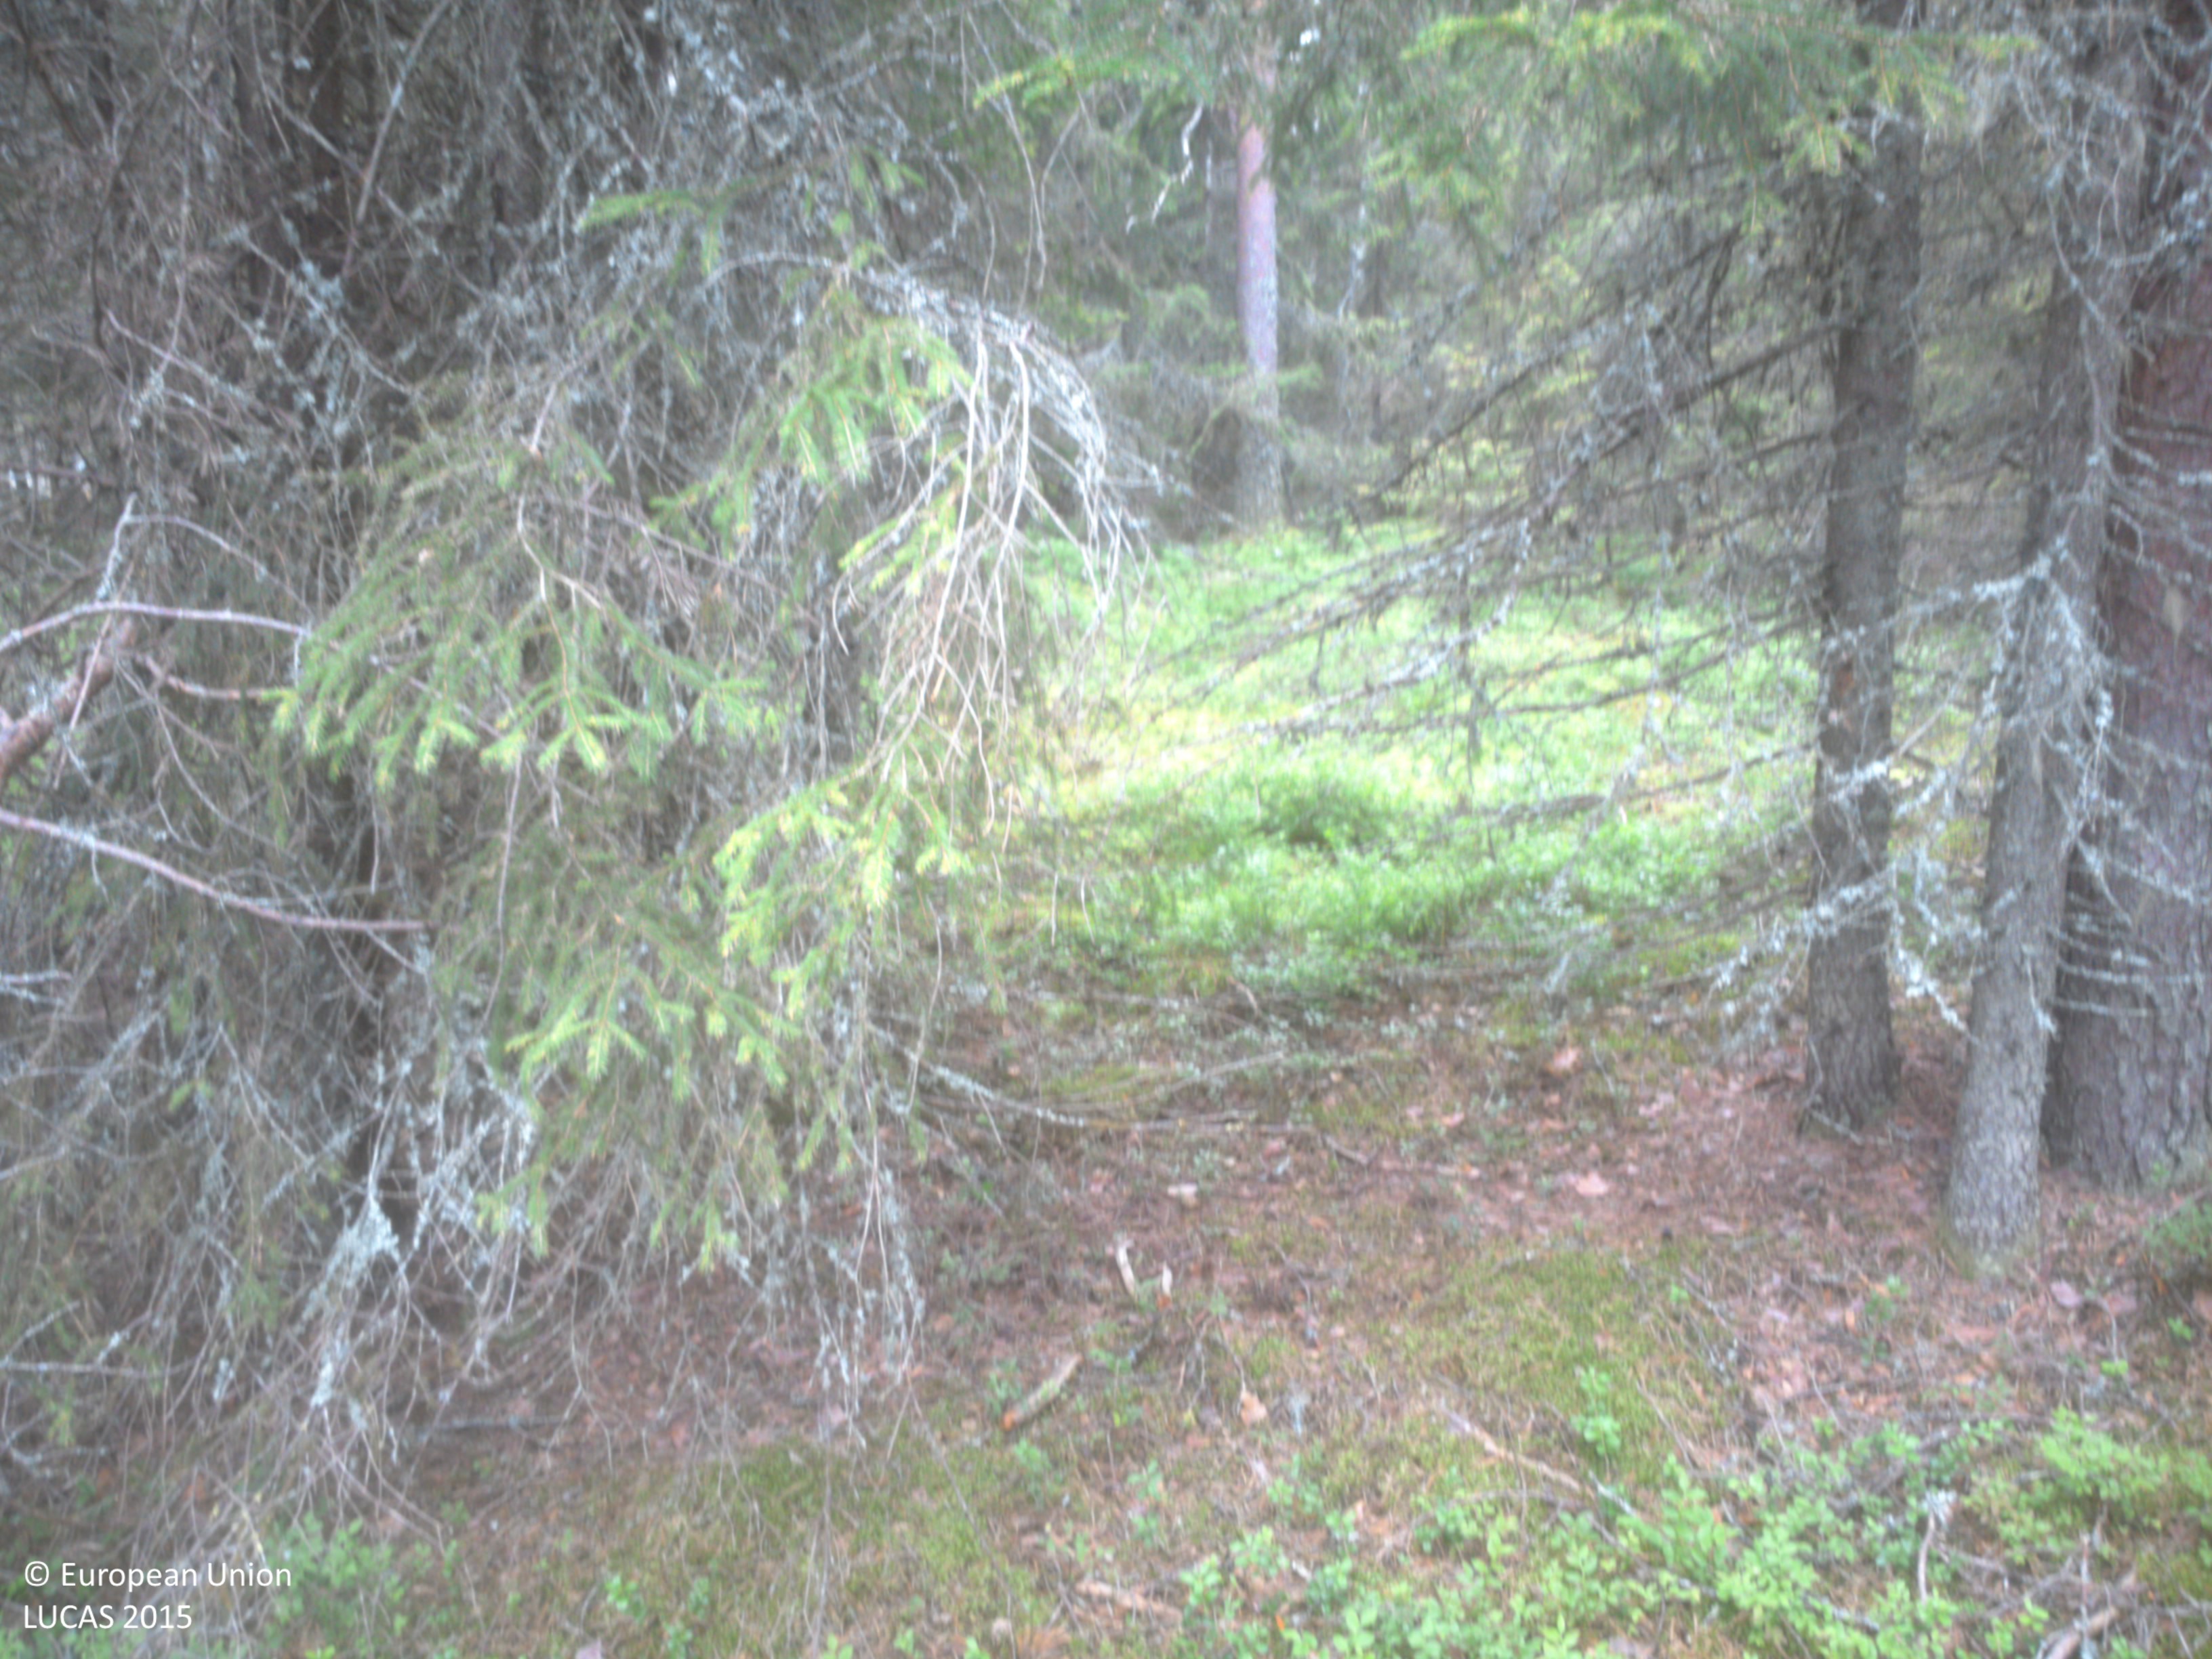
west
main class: Woodland
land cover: Other coniferous woodland
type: boreal forest
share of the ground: 50 - 75 %
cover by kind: coniferous forest trees 70 %, shrubs 20 %, lichens and mosses 10 %
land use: Forestry
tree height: > 5 m
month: August
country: SE
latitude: 63.7428
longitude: 19.8873
